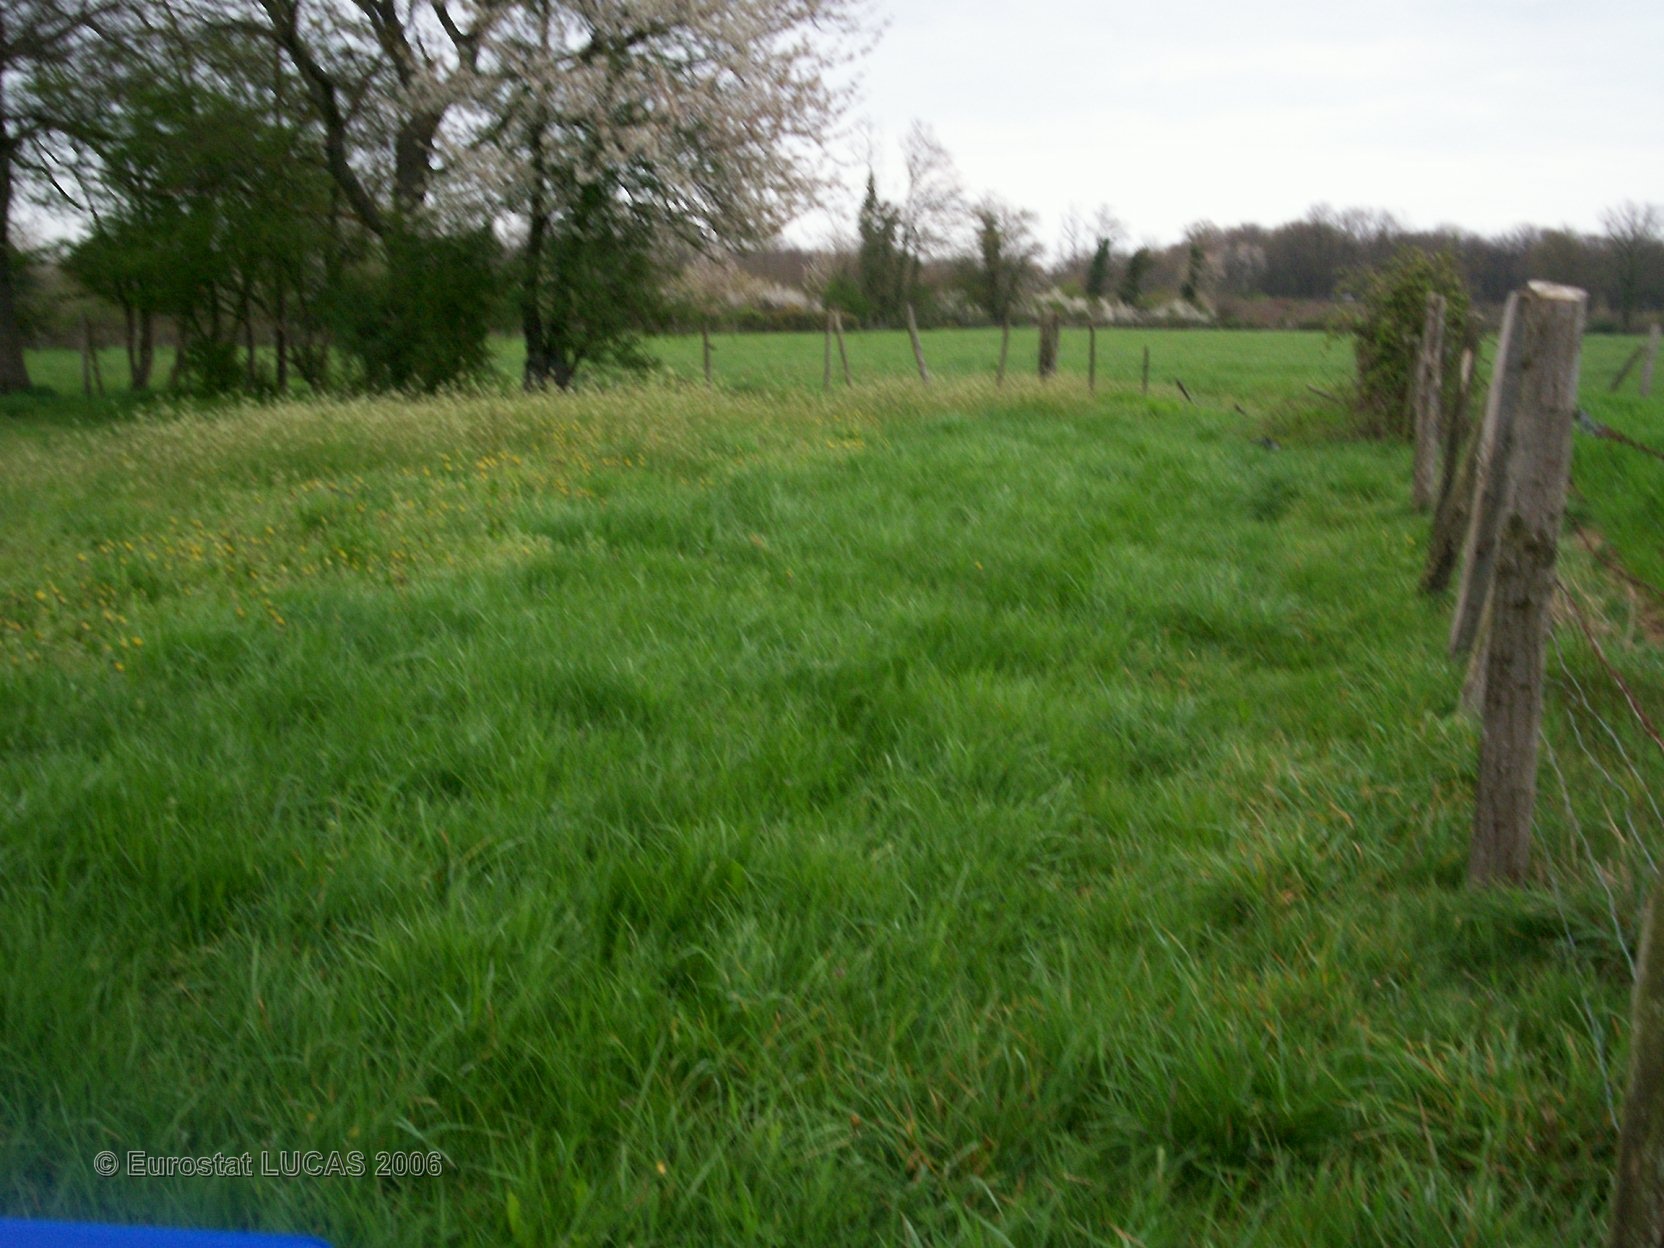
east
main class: Grassland
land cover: Grassland without tree/shrub cover
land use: Agriculture (excluding fallow land and kitchen gardens)
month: April
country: FR
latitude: 46.8438
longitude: -0.3730
